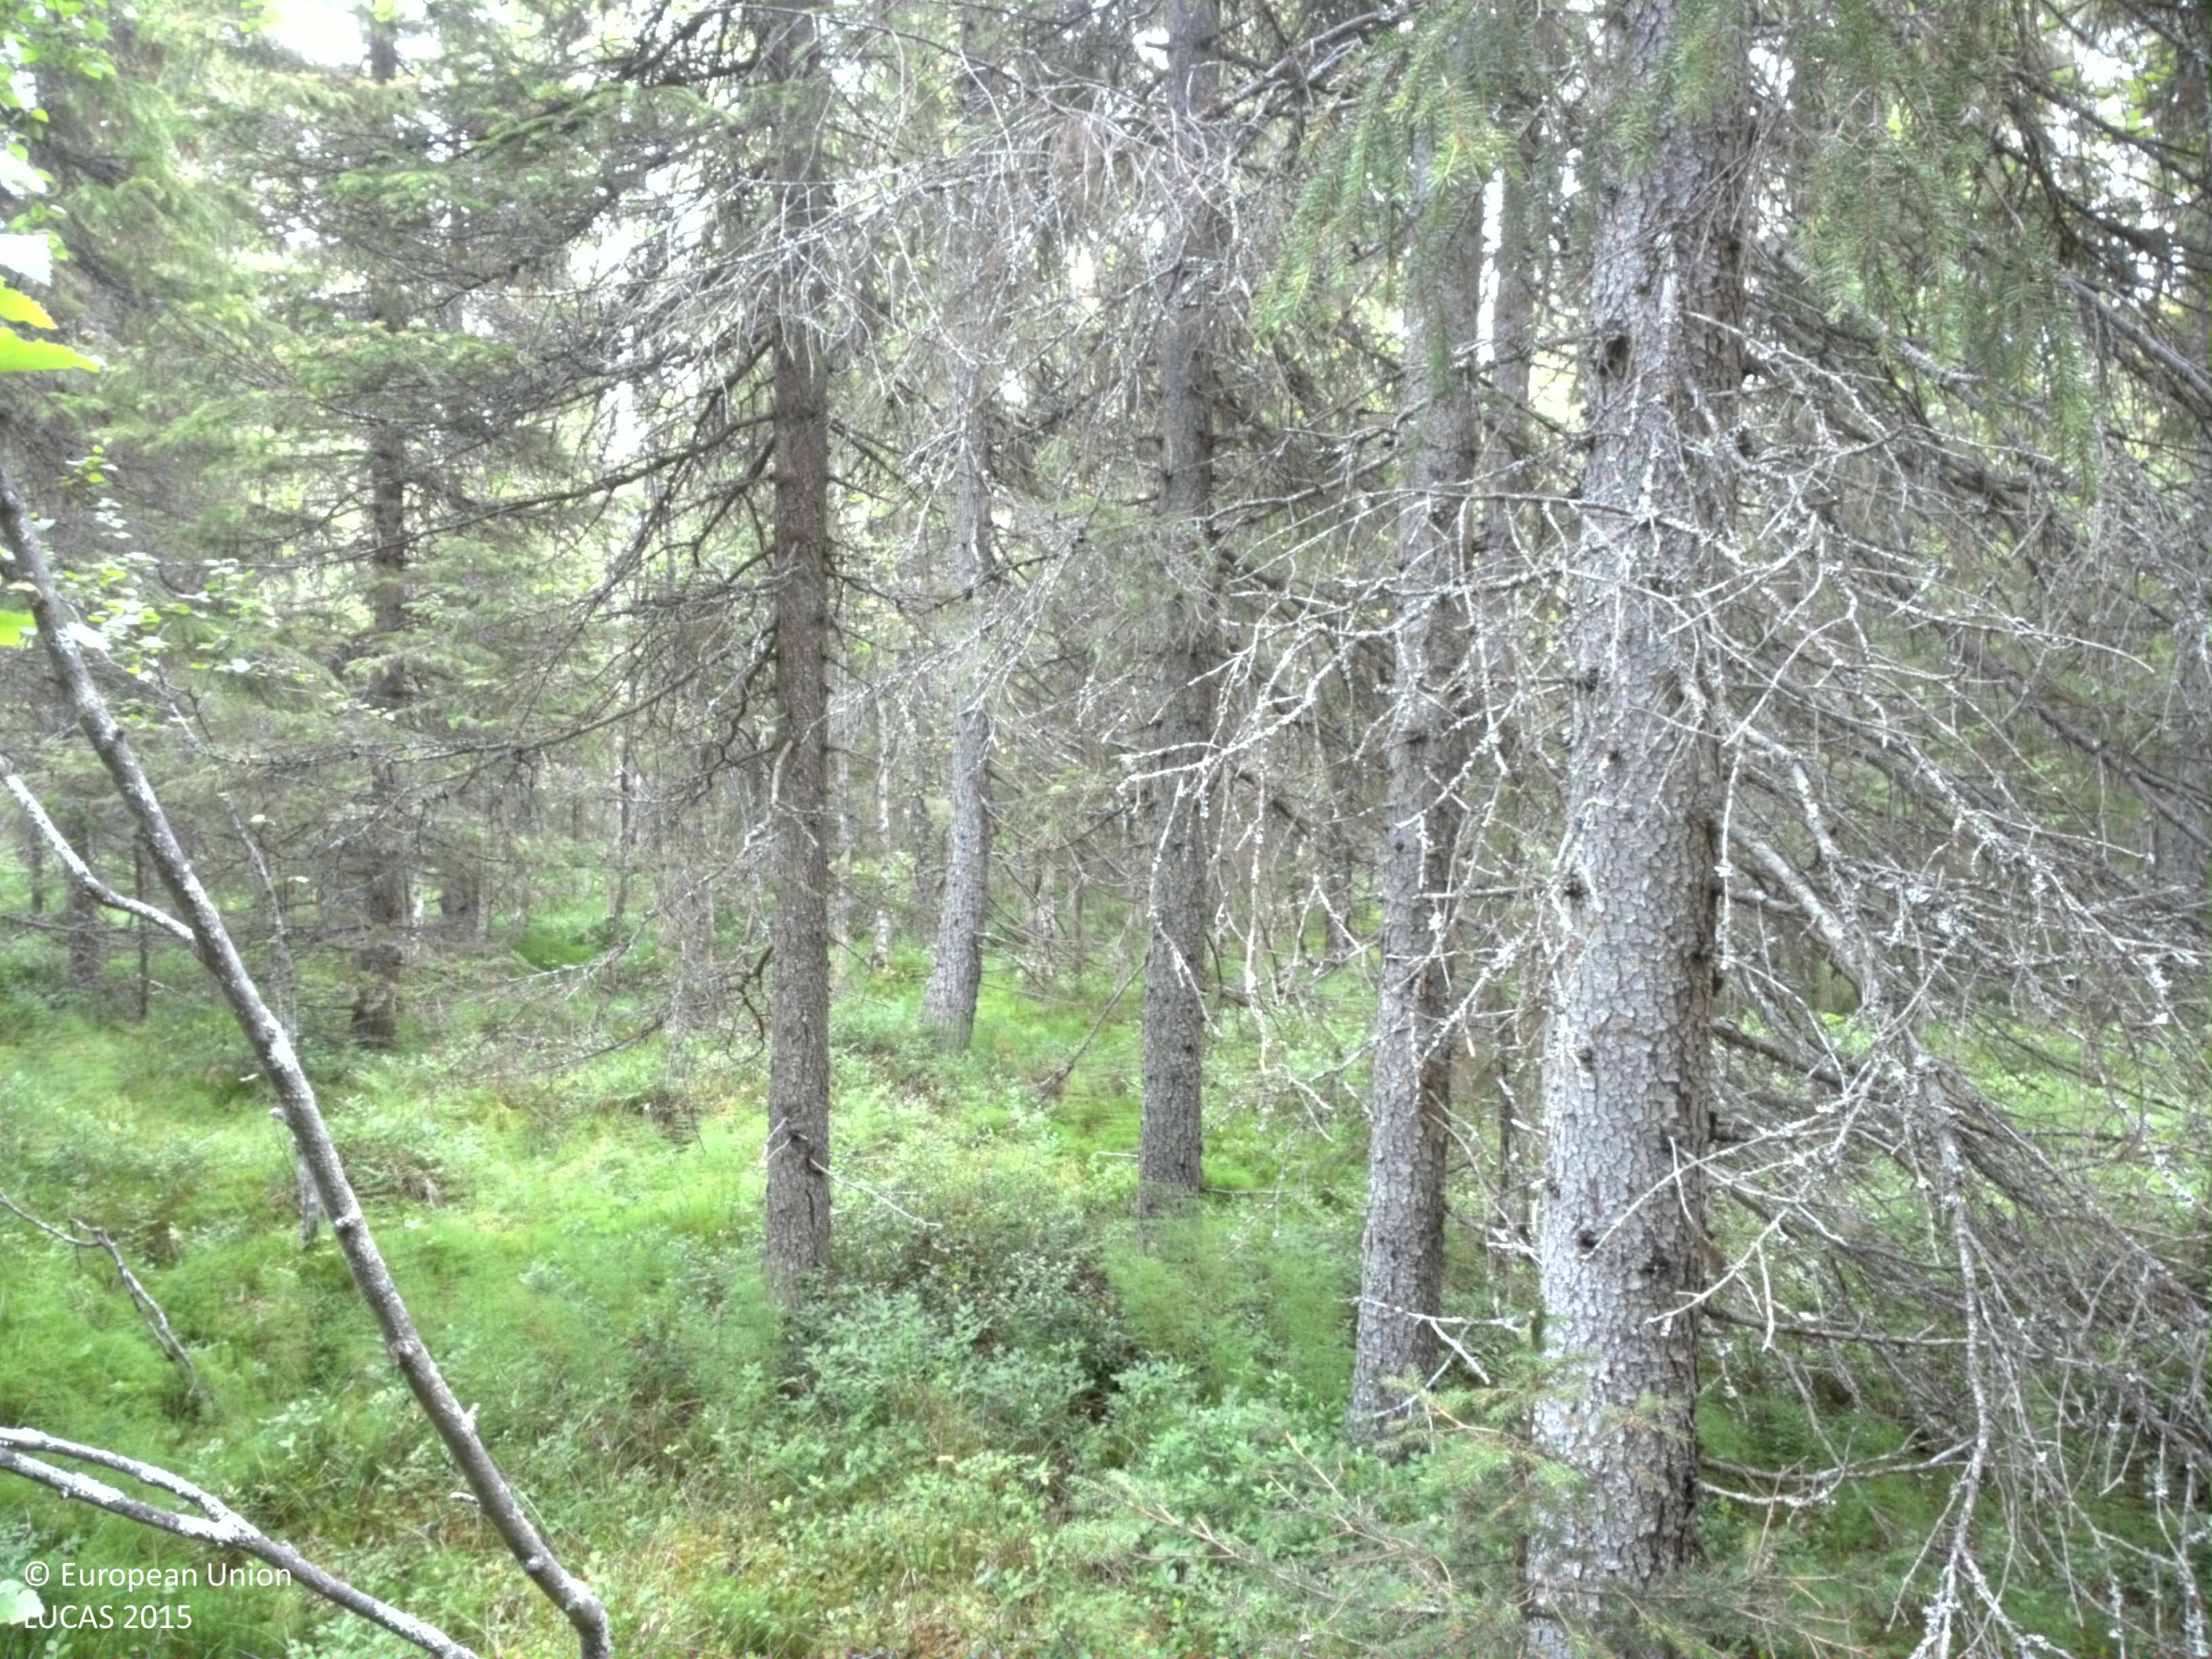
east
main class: Woodland
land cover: Spruce dominated coniferous woodland
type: boreal forest
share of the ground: 50 - 75 %
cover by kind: coniferous forest trees 60 %, shrubs 15 %, herbaceous plants 10 %, lichens and mosses 10 %, broadleaved forest trees 5 %
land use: Forestry
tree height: > 5 m
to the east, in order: Spruce dominated coniferous woodland; Ditches and canals; Spruce dominated mixed woodland; Broadleaved woodland; Spruce dominated mixed woodland; Ditches and canals; Other mixed woodland
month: August
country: SE
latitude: 64.5450
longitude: 20.1717
